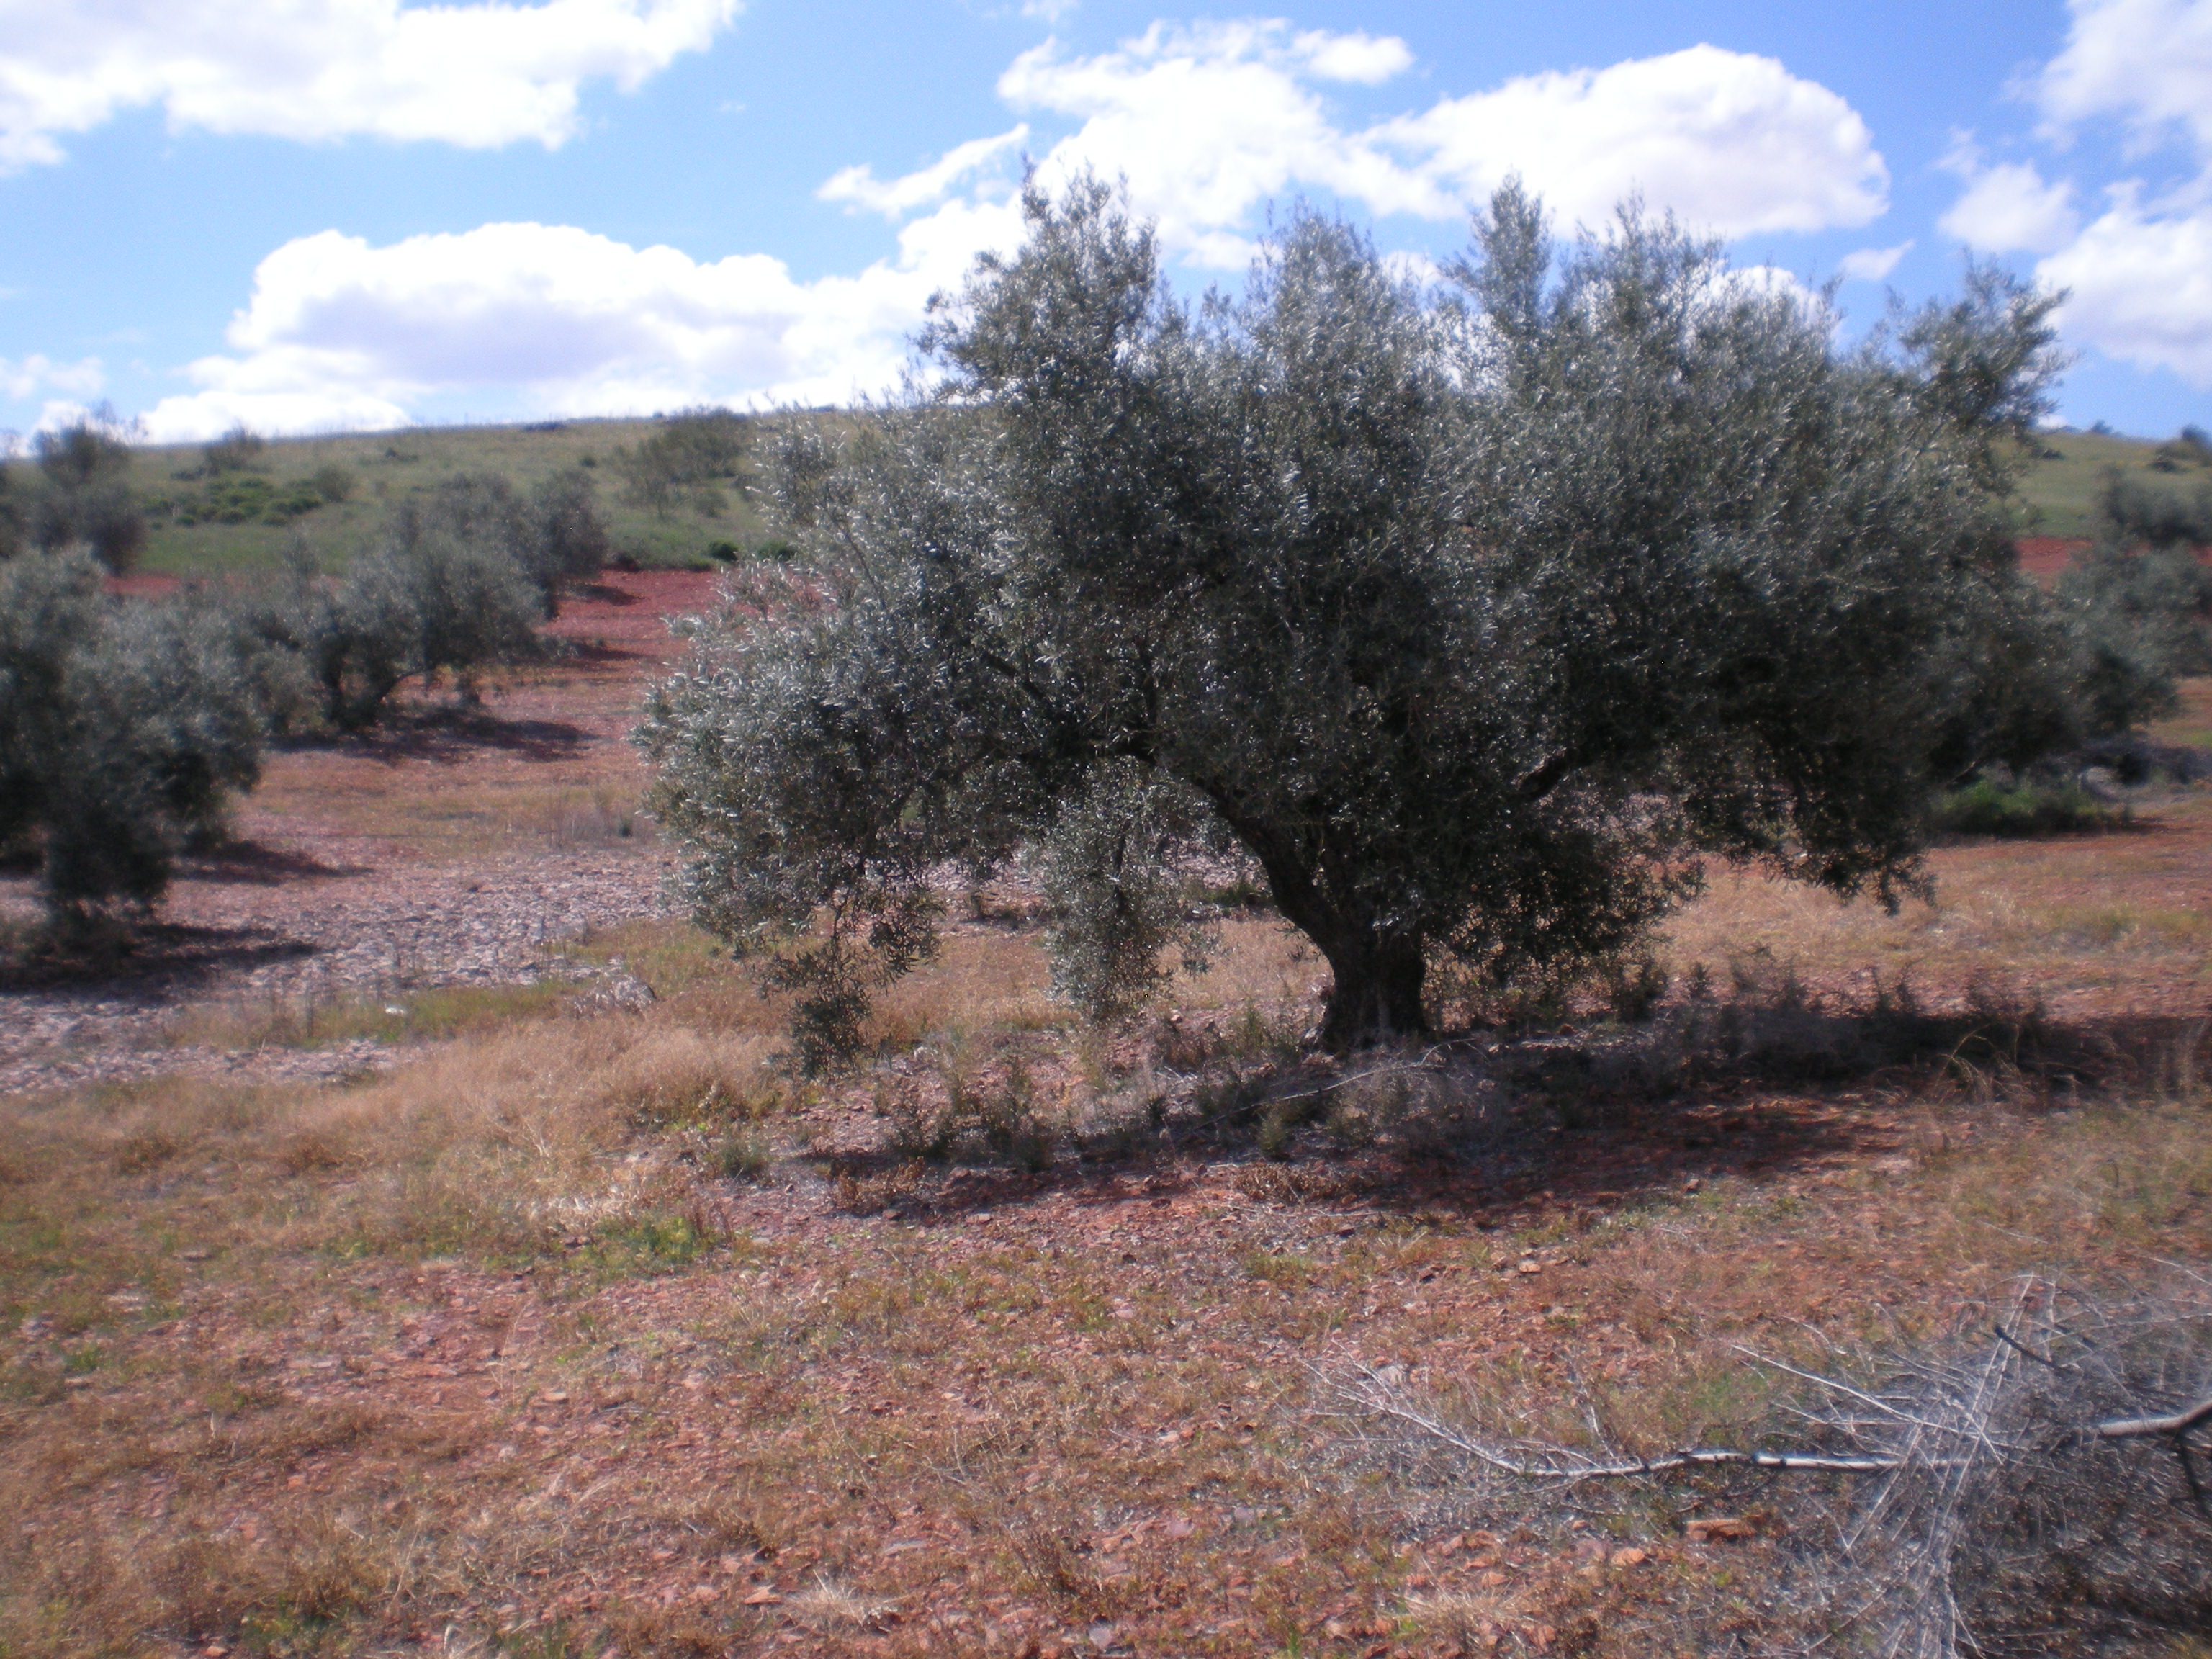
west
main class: Cropland
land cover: Olive groves
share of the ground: 25 - 50 %
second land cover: Other bare soil
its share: > 75 %
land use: Agriculture (excluding fallow land and kitchen gardens)
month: April
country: ES
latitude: 38.7567
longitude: -3.5337
